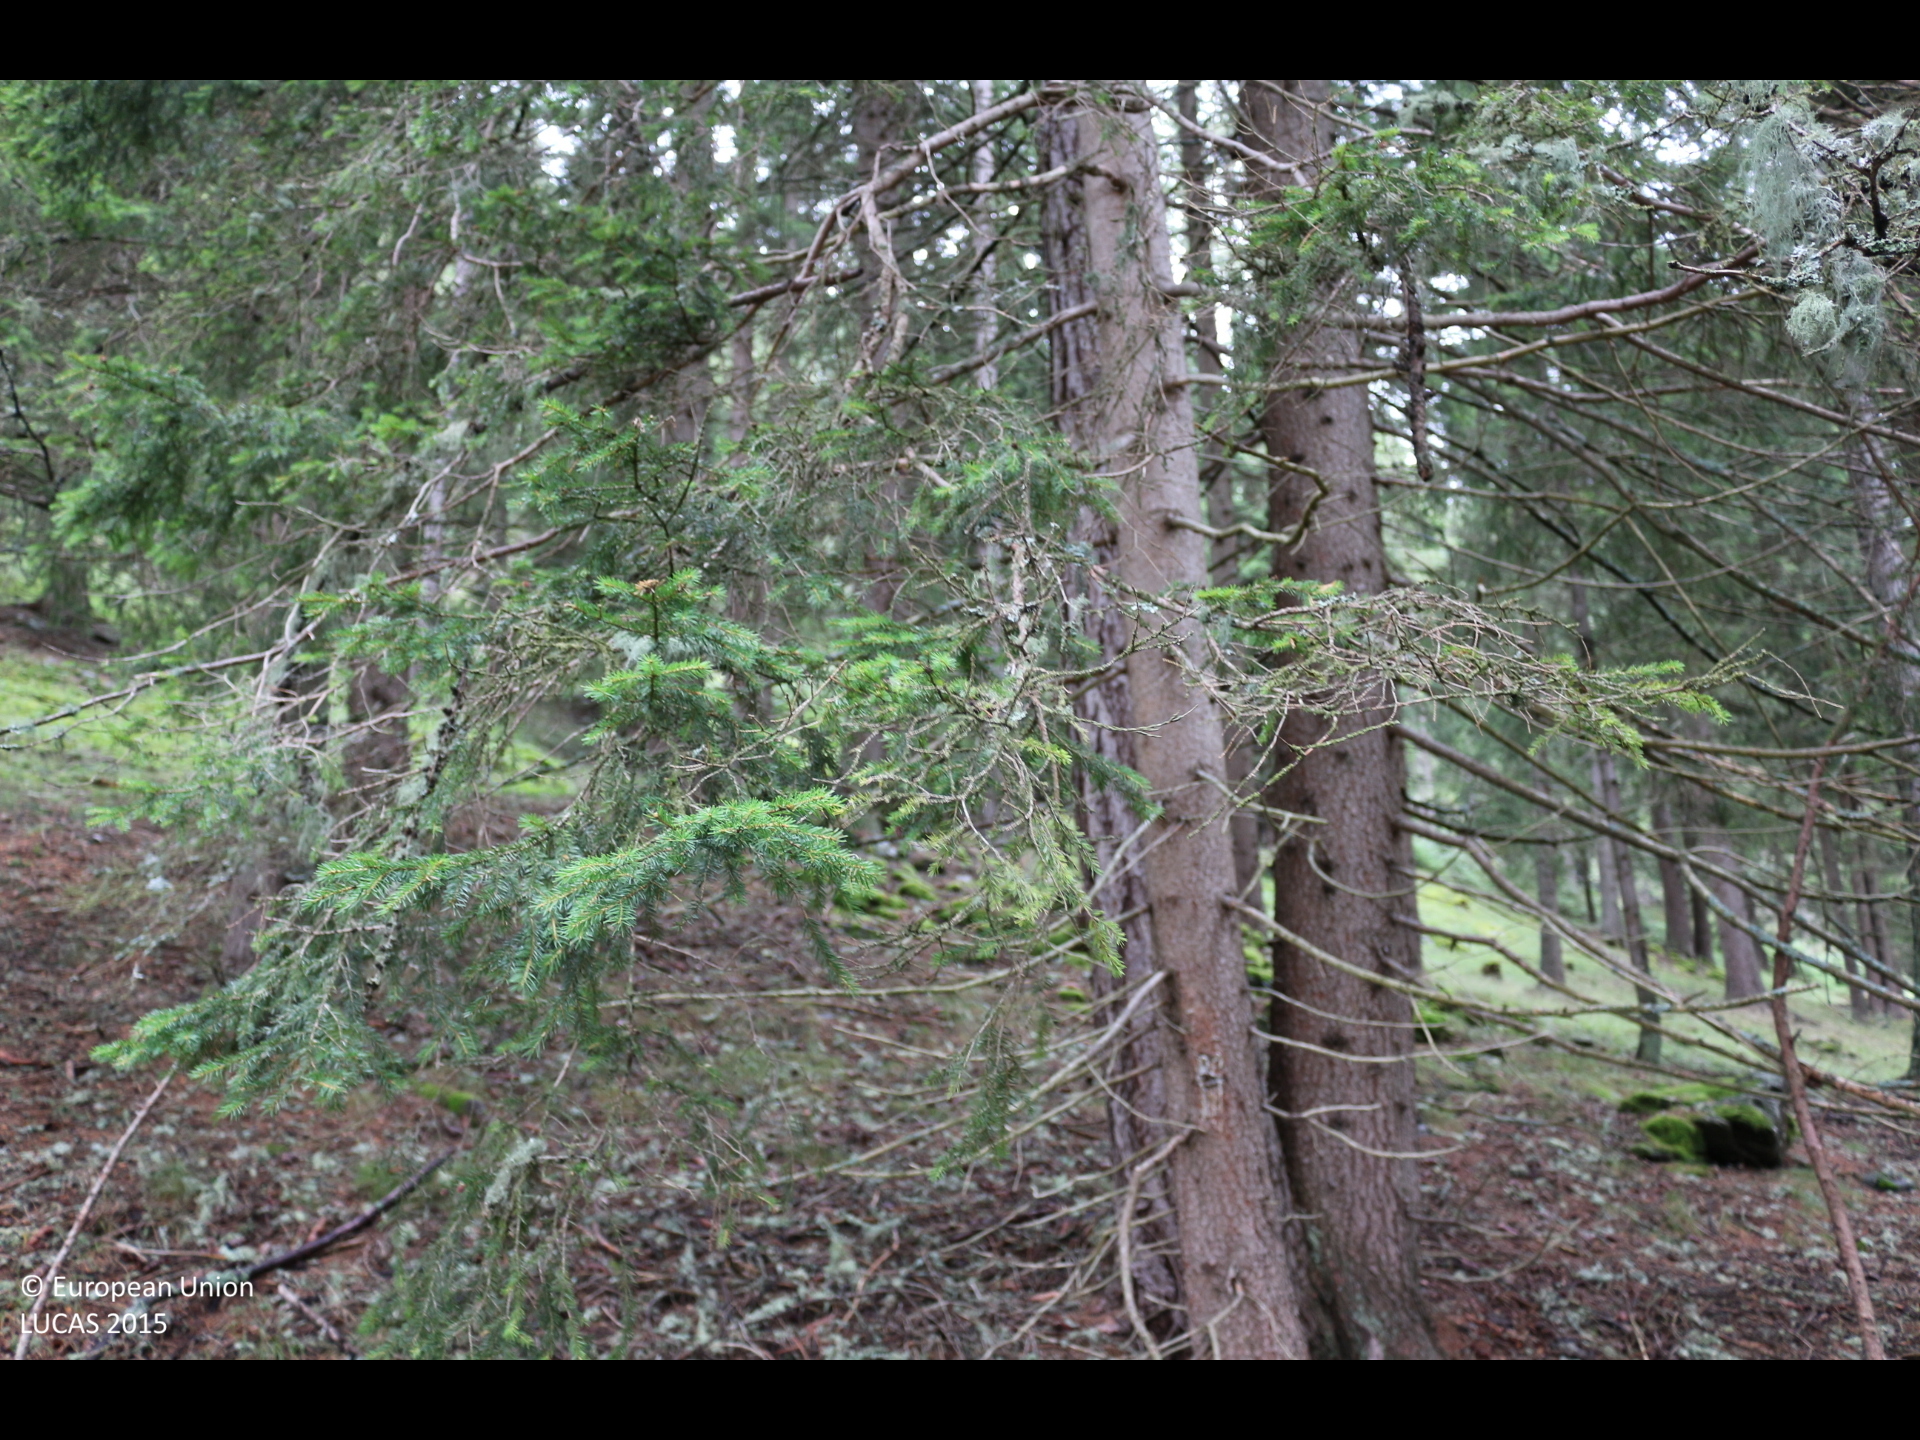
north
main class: Woodland
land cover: Spruce dominated coniferous woodland
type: alpine coniferous forest
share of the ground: > 75 %
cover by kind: coniferous forest trees 95 %, herbaceous plants 5 %
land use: Forestry
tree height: > 5 m
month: July
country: AT
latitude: 47.0242
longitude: 14.2478
